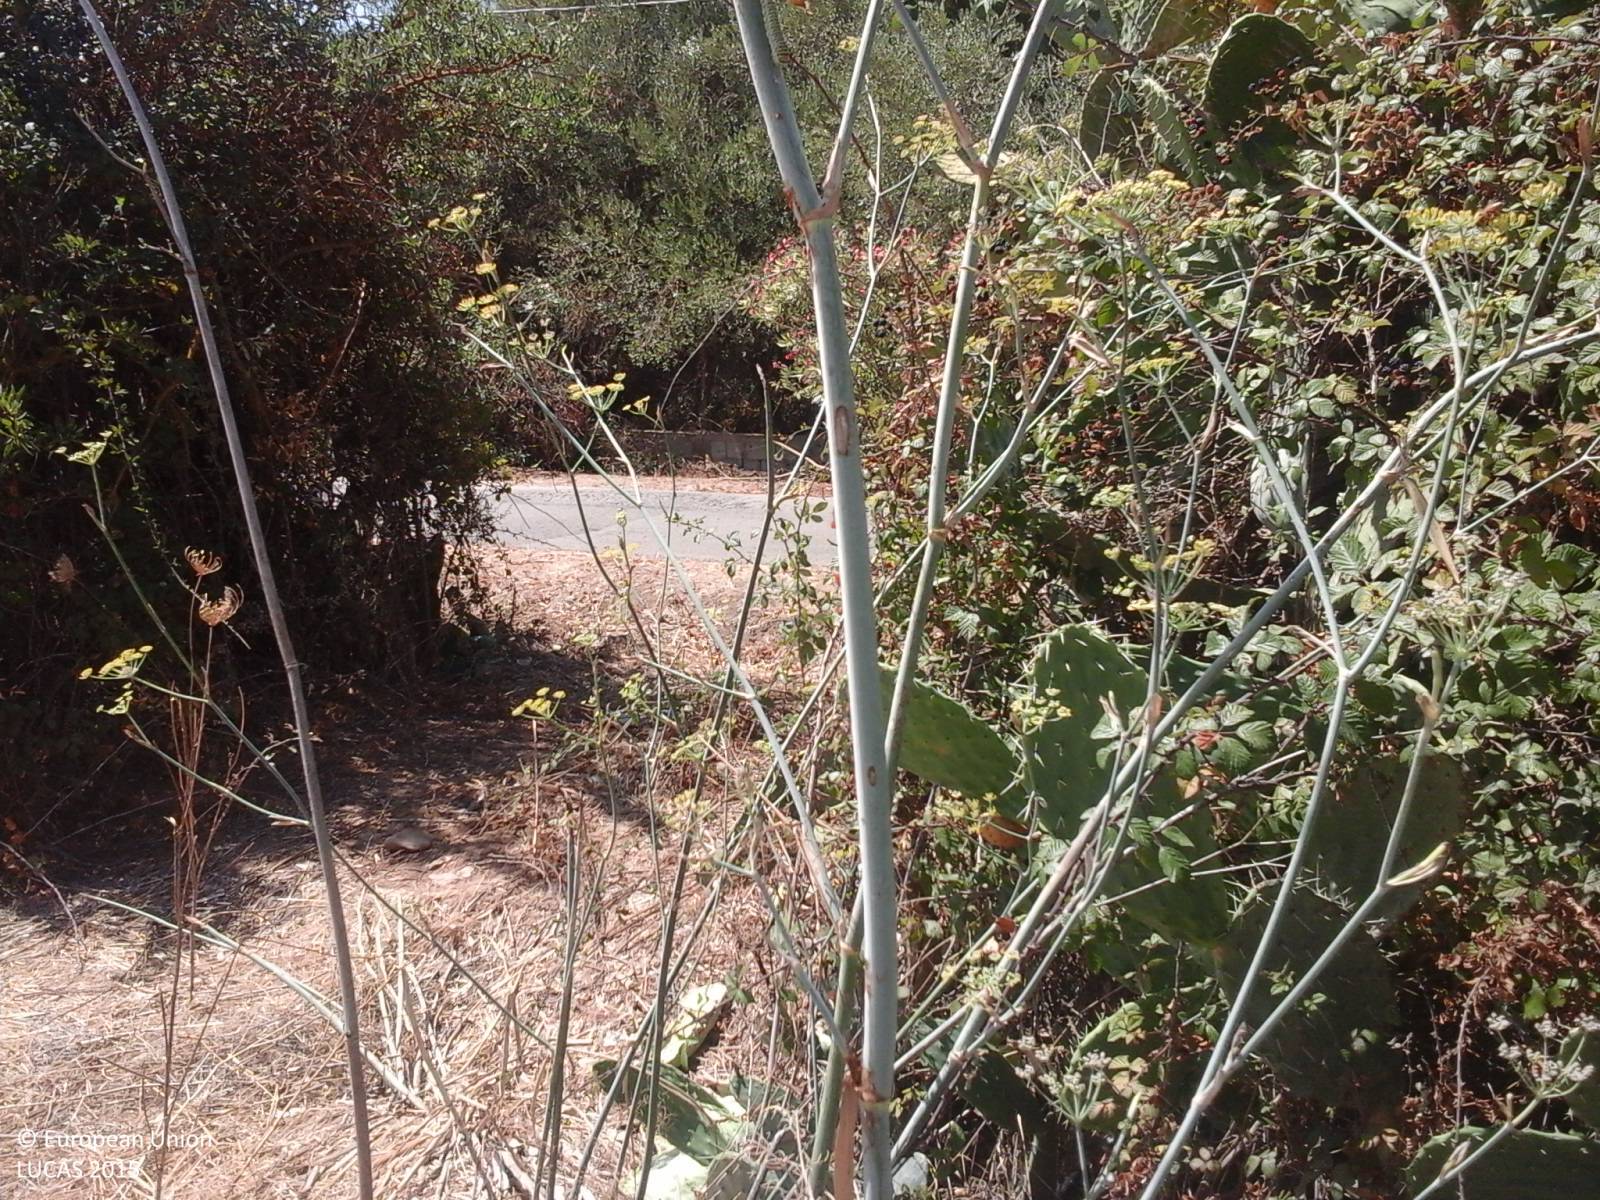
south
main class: Grassland
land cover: Grassland without tree/shrub cover
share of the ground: > 75 %
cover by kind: herbaceous plants 100 %
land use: Agriculture (excluding fallow land and kitchen gardens)
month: August
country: IT
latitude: 39.3723
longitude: 8.7885
